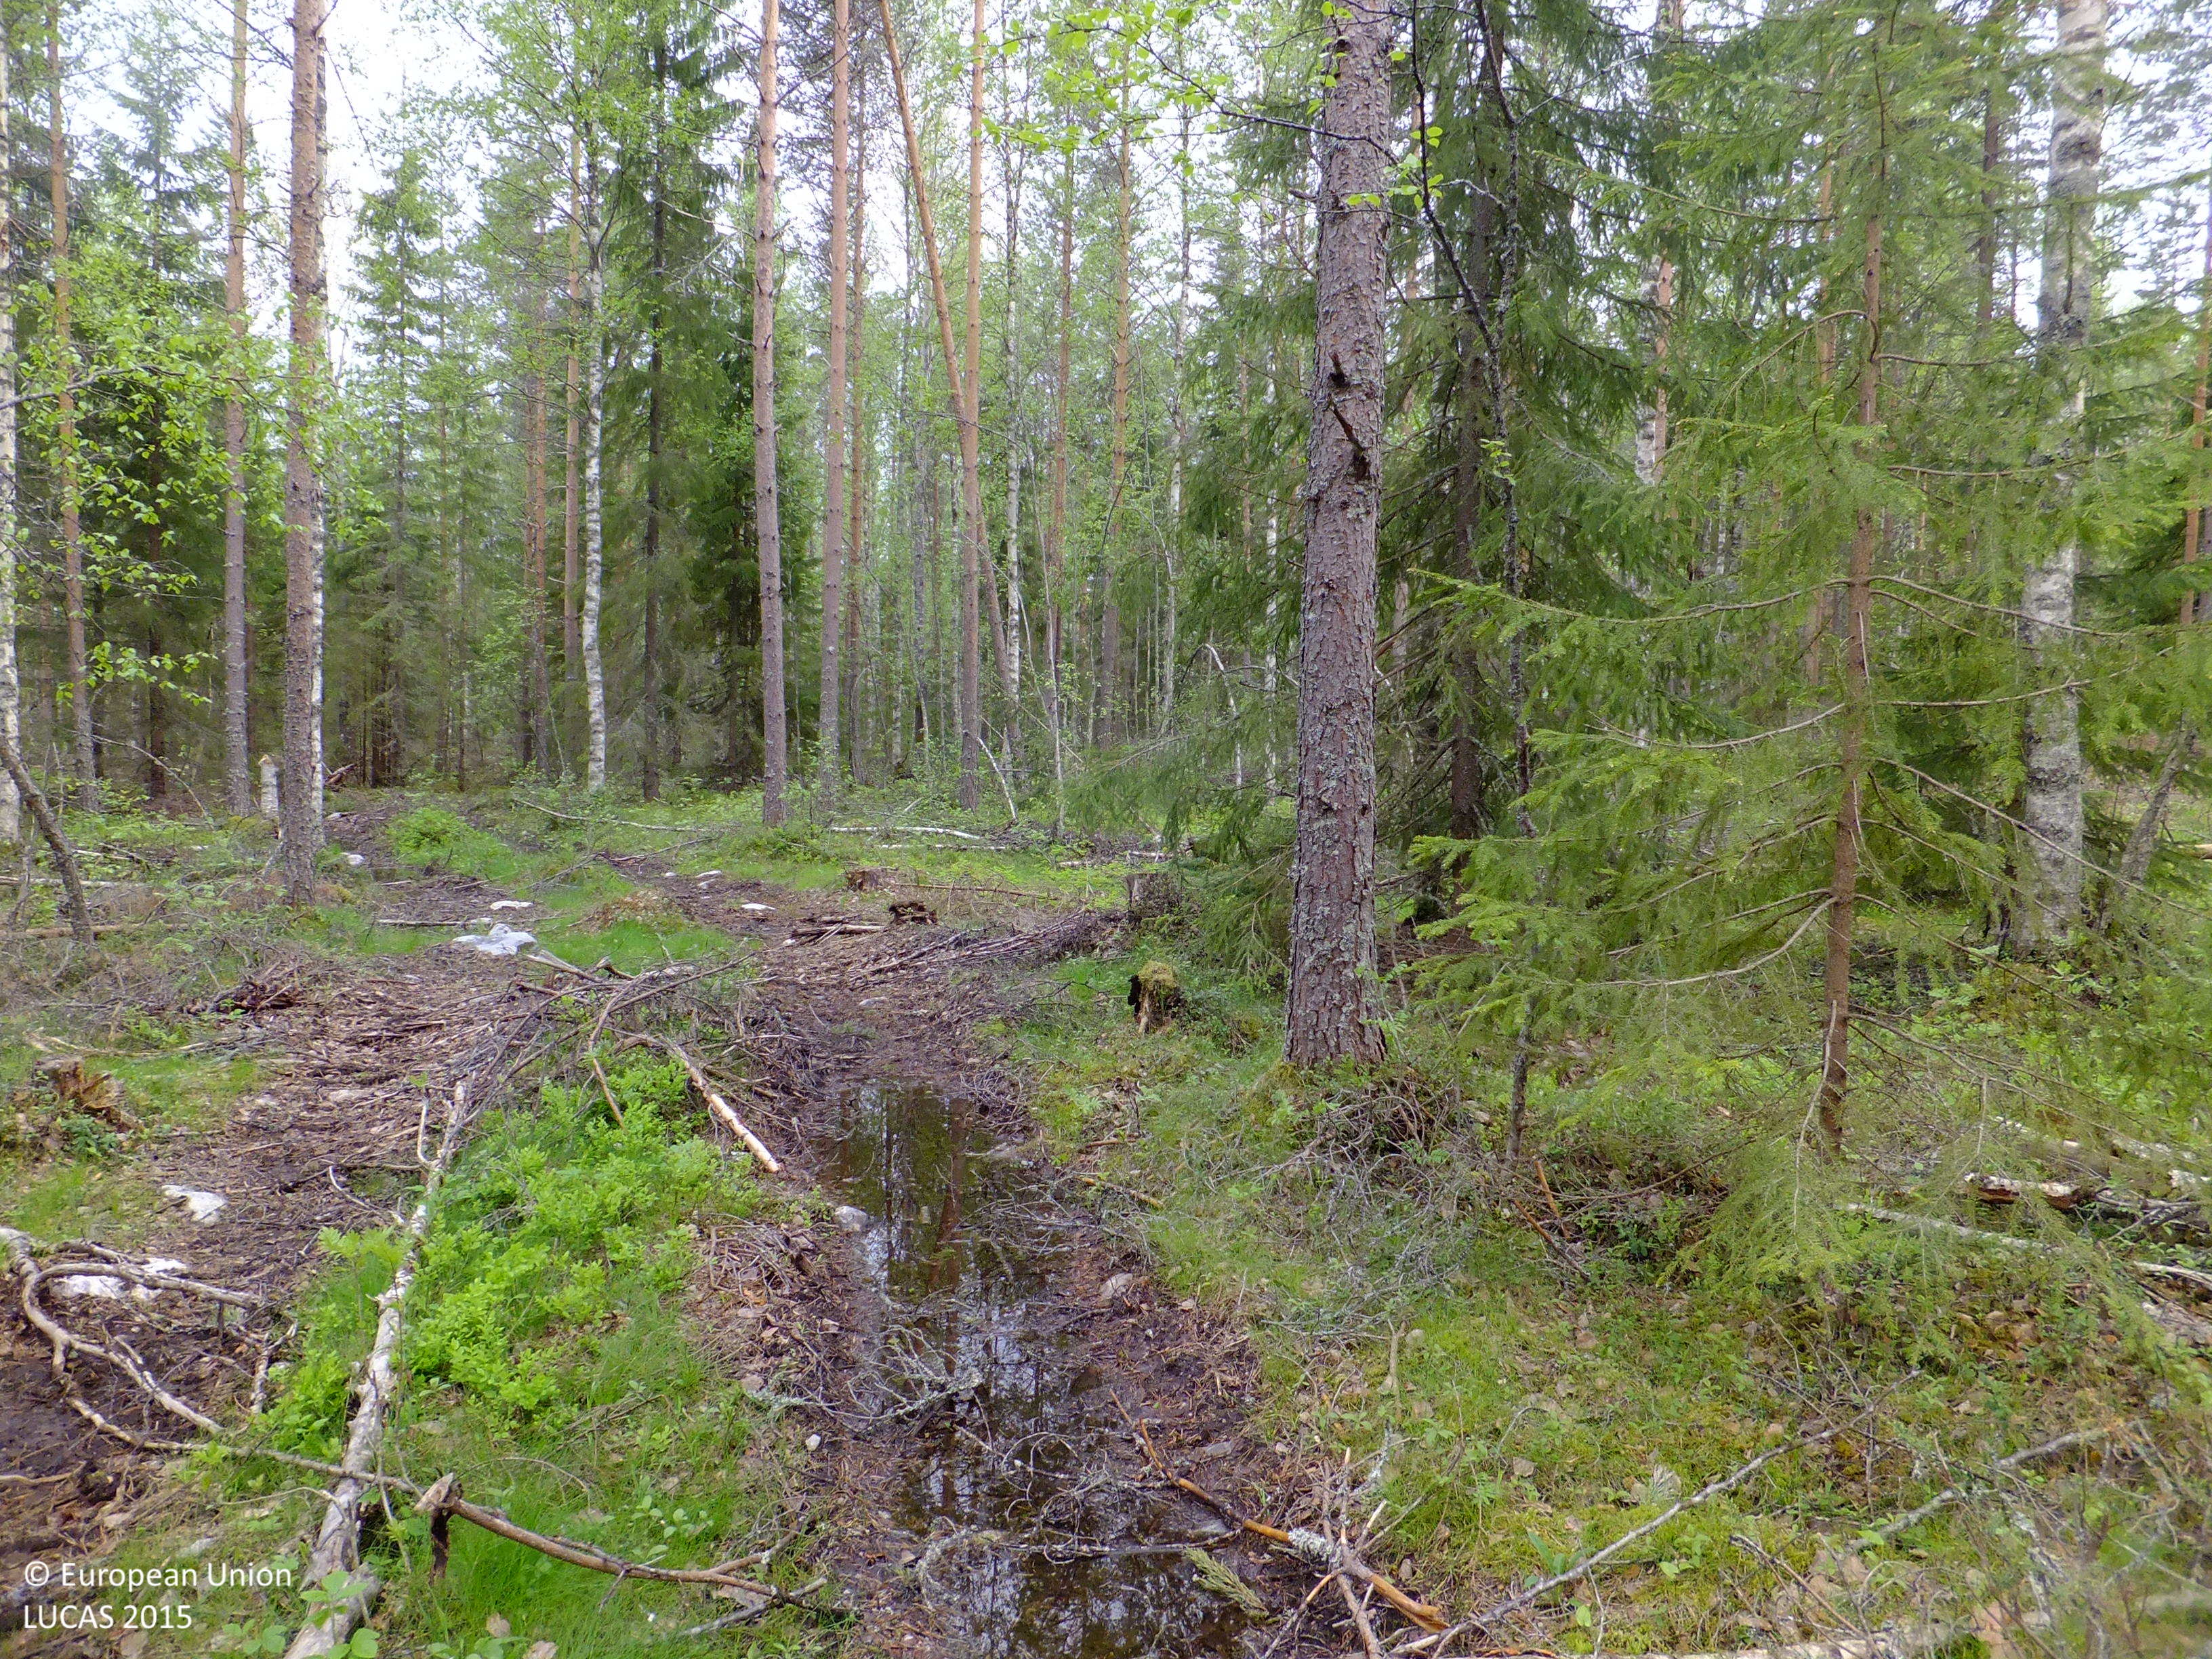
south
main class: Woodland
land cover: Pine dominated mixed woodland
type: boreal forest
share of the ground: > 75 %
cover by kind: coniferous forest trees 50 %, broadleaved forest trees 25 %, herbaceous plants 10 %, lichens and mosses 10 %, shrubs 5 %
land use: Forestry
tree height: > 5 m
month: June
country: FI
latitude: 63.4234
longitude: 23.1800
